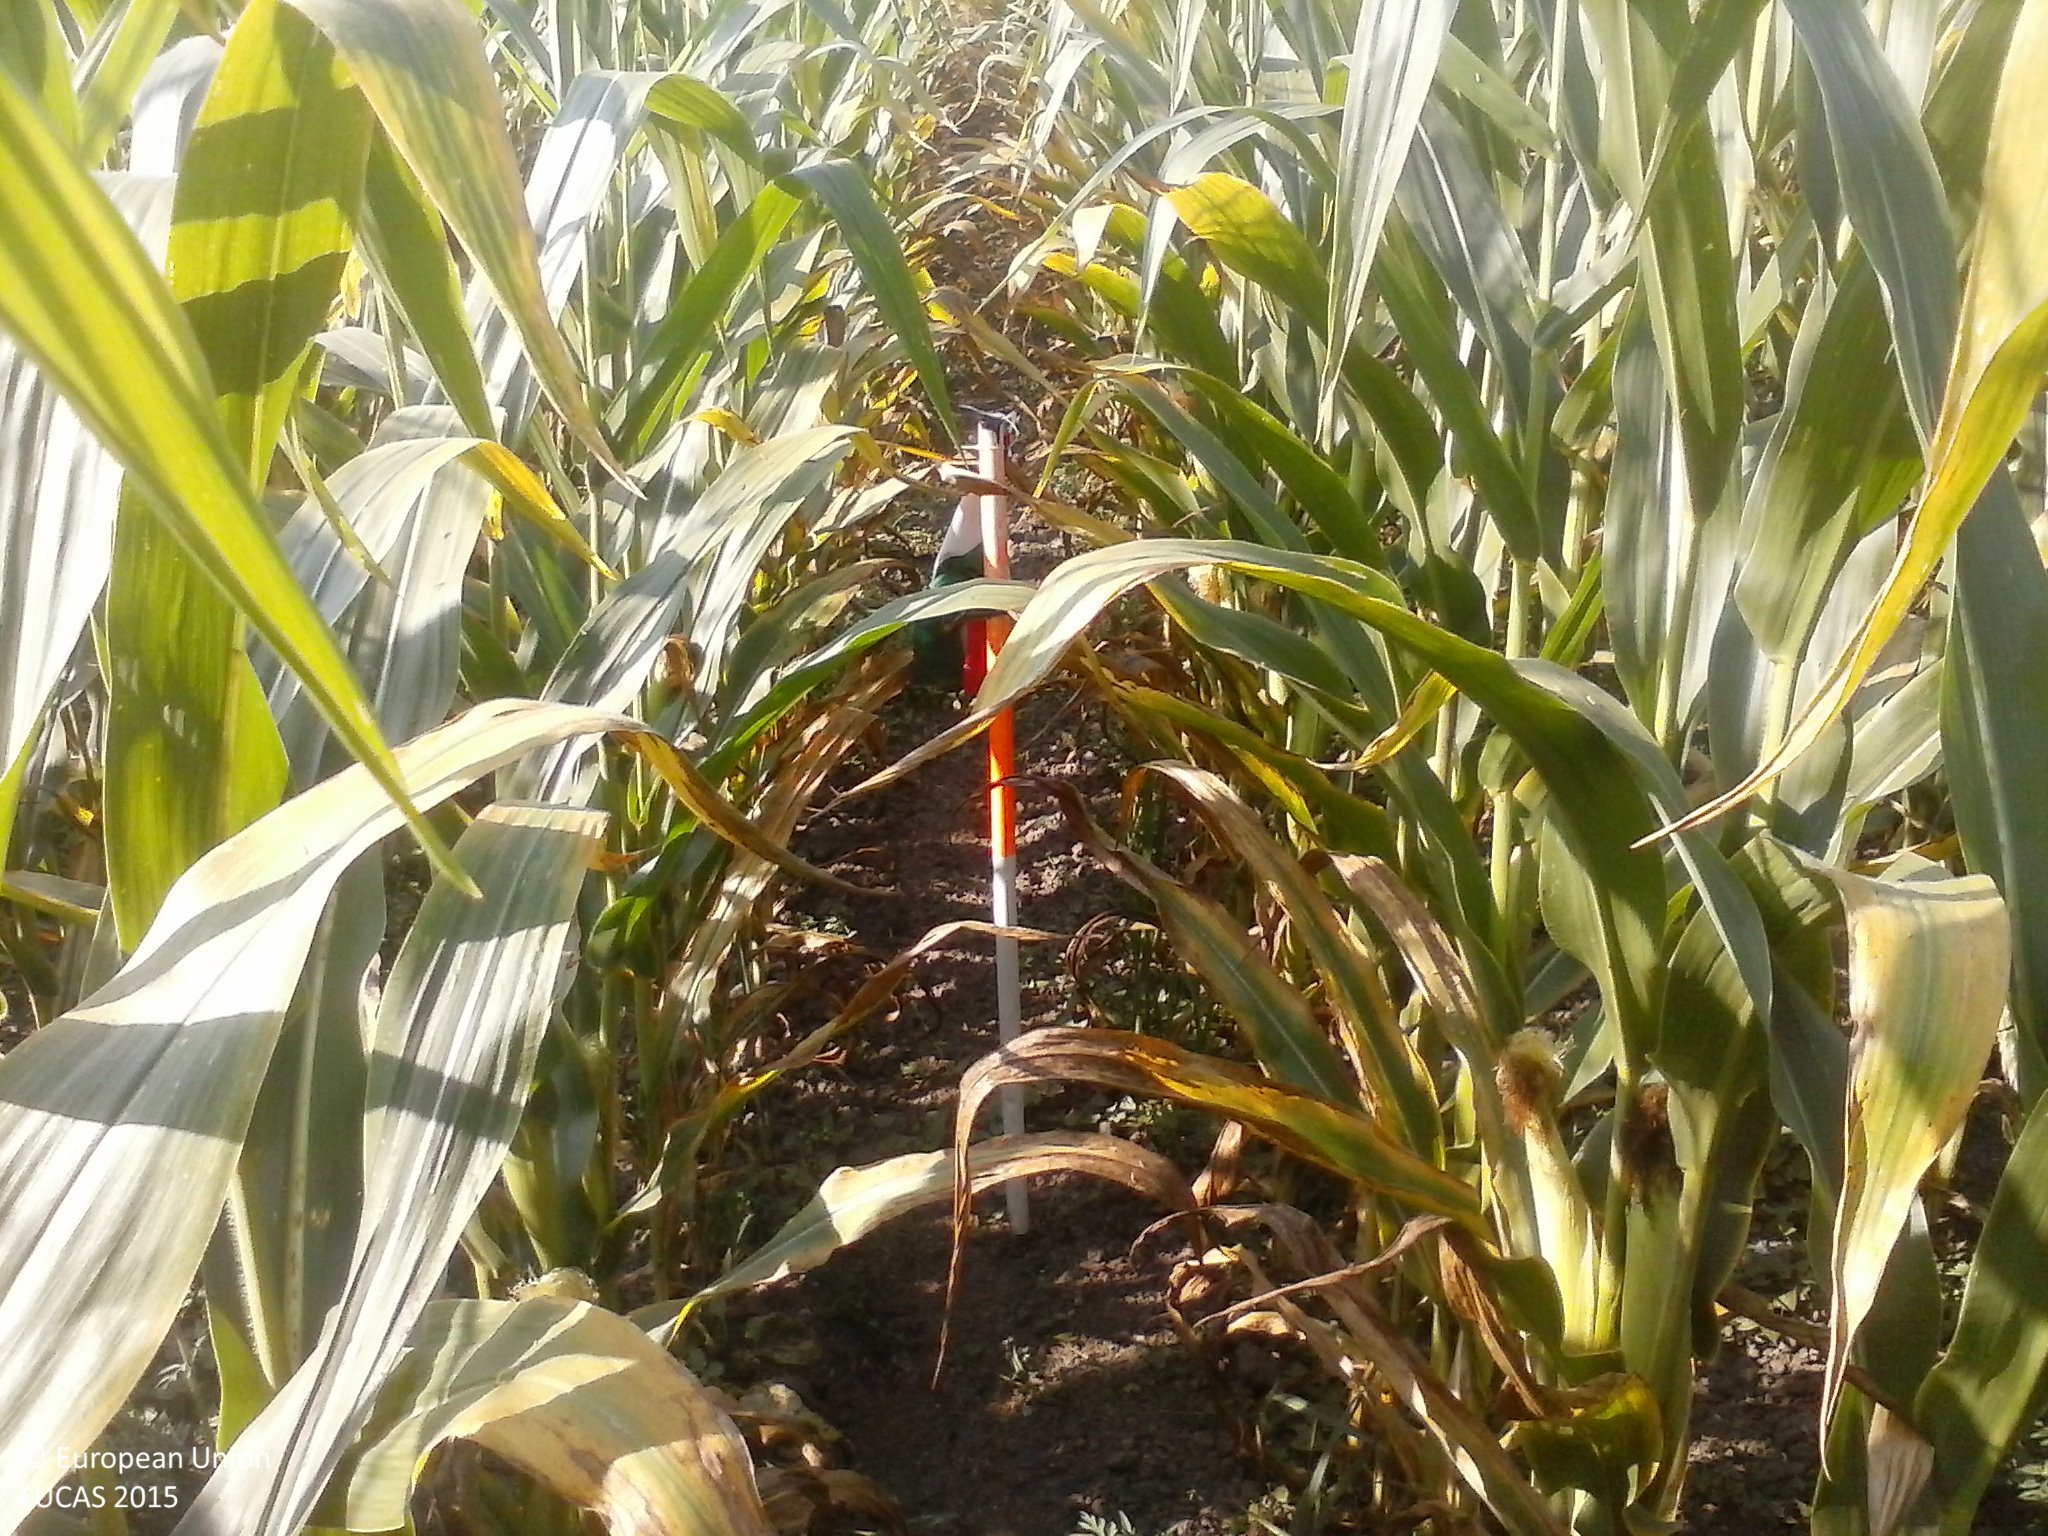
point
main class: Cropland
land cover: Maize
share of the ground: > 75 %
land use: Agriculture (excluding fallow land and kitchen gardens)
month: August
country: HU
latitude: 45.8955
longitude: 17.9052
